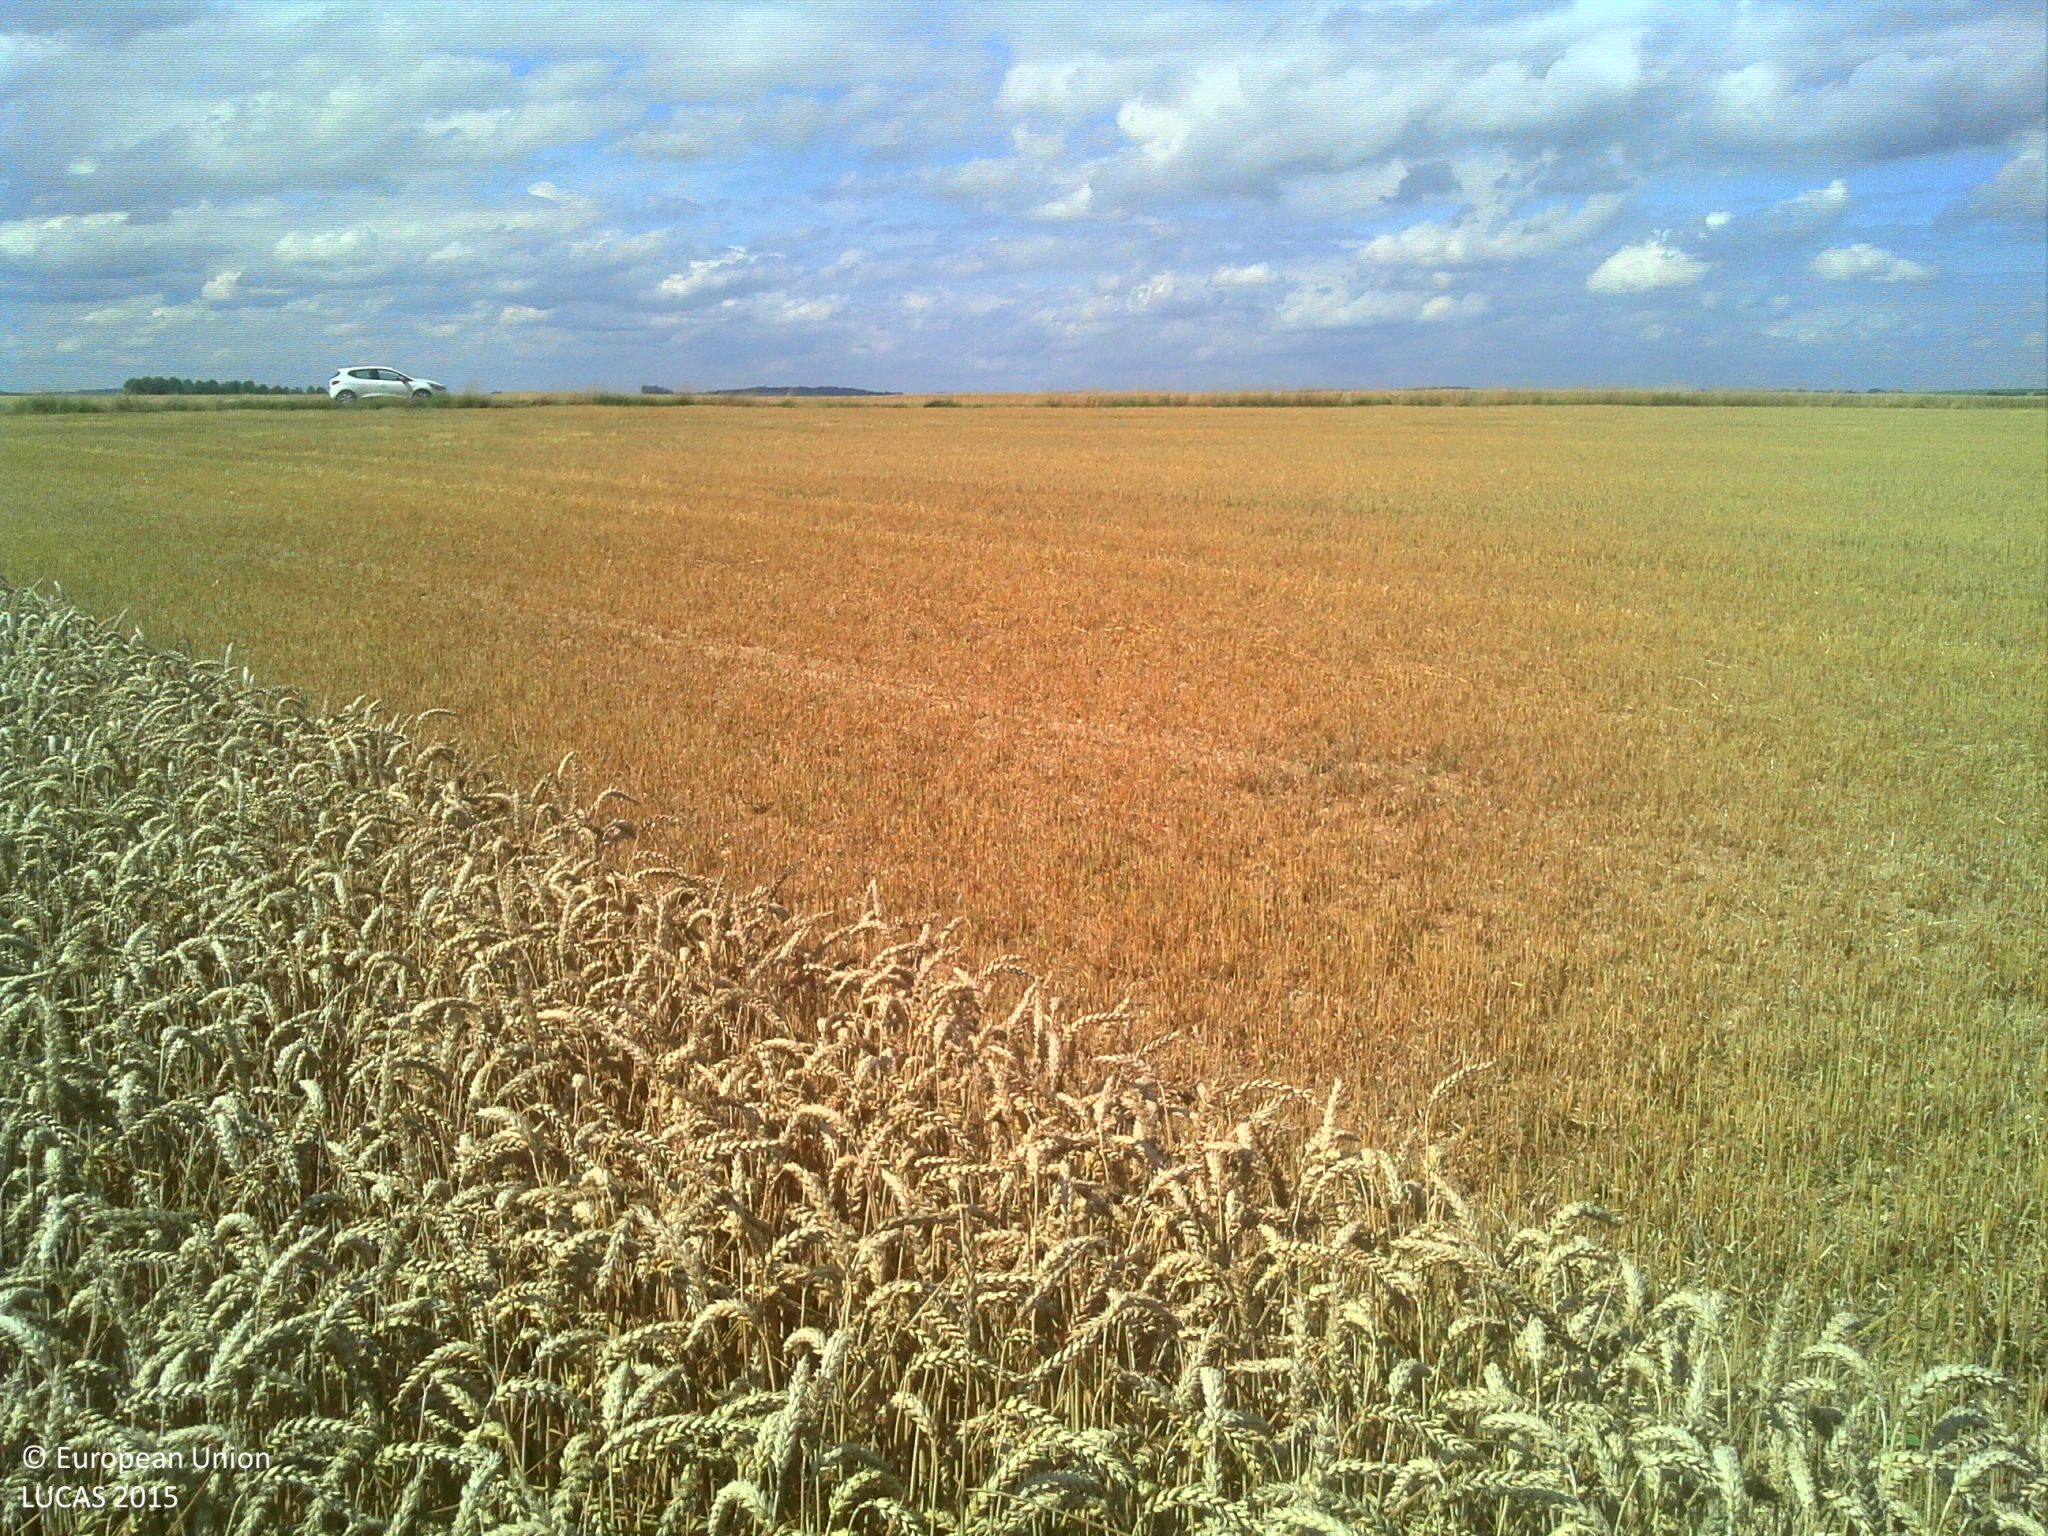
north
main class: Cropland
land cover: Common wheat
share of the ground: > 75 %
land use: Agriculture (excluding fallow land and kitchen gardens)
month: July
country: FR
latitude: 49.7547
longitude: 3.6499
